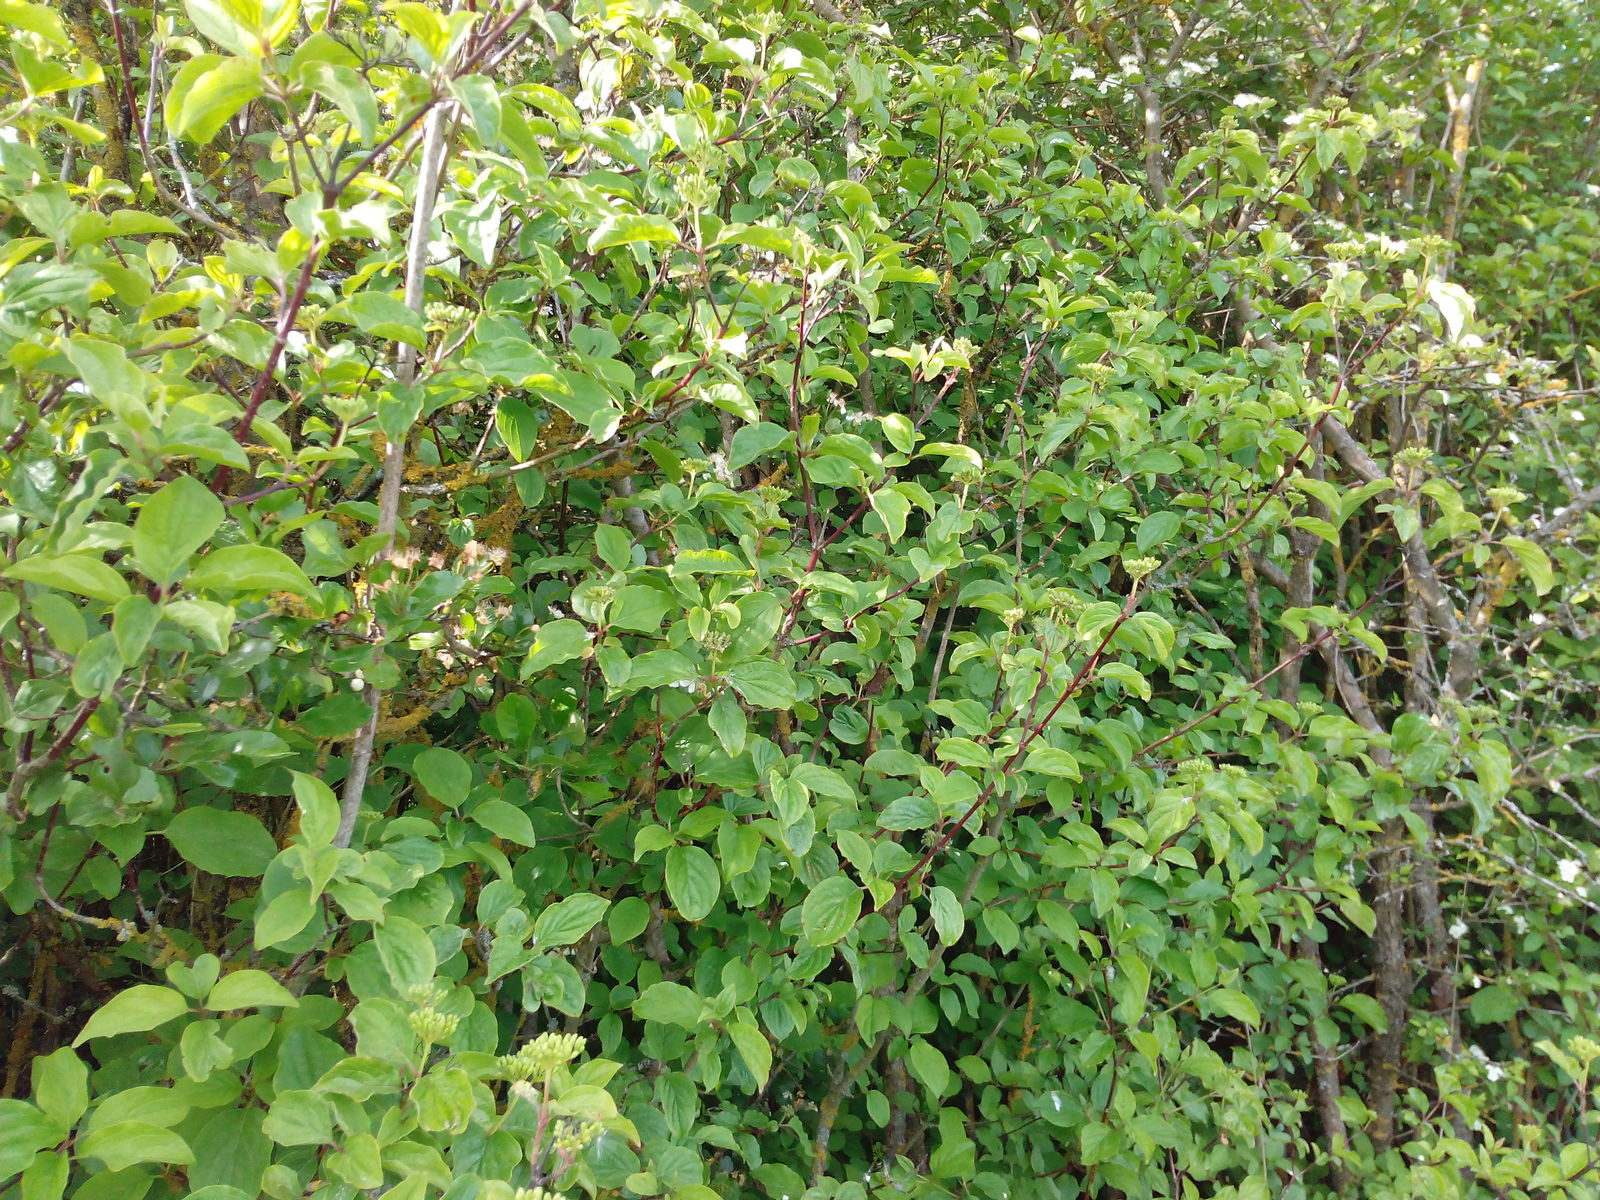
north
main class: Shrubland
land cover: Shrubland with sparse tree cover
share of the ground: > 75 %
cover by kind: shrubs 95 %, broadleaved forest trees 5 %
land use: Semi-natural and natural areas not in use
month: May
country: DE
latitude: 50.3970
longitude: 10.8297
